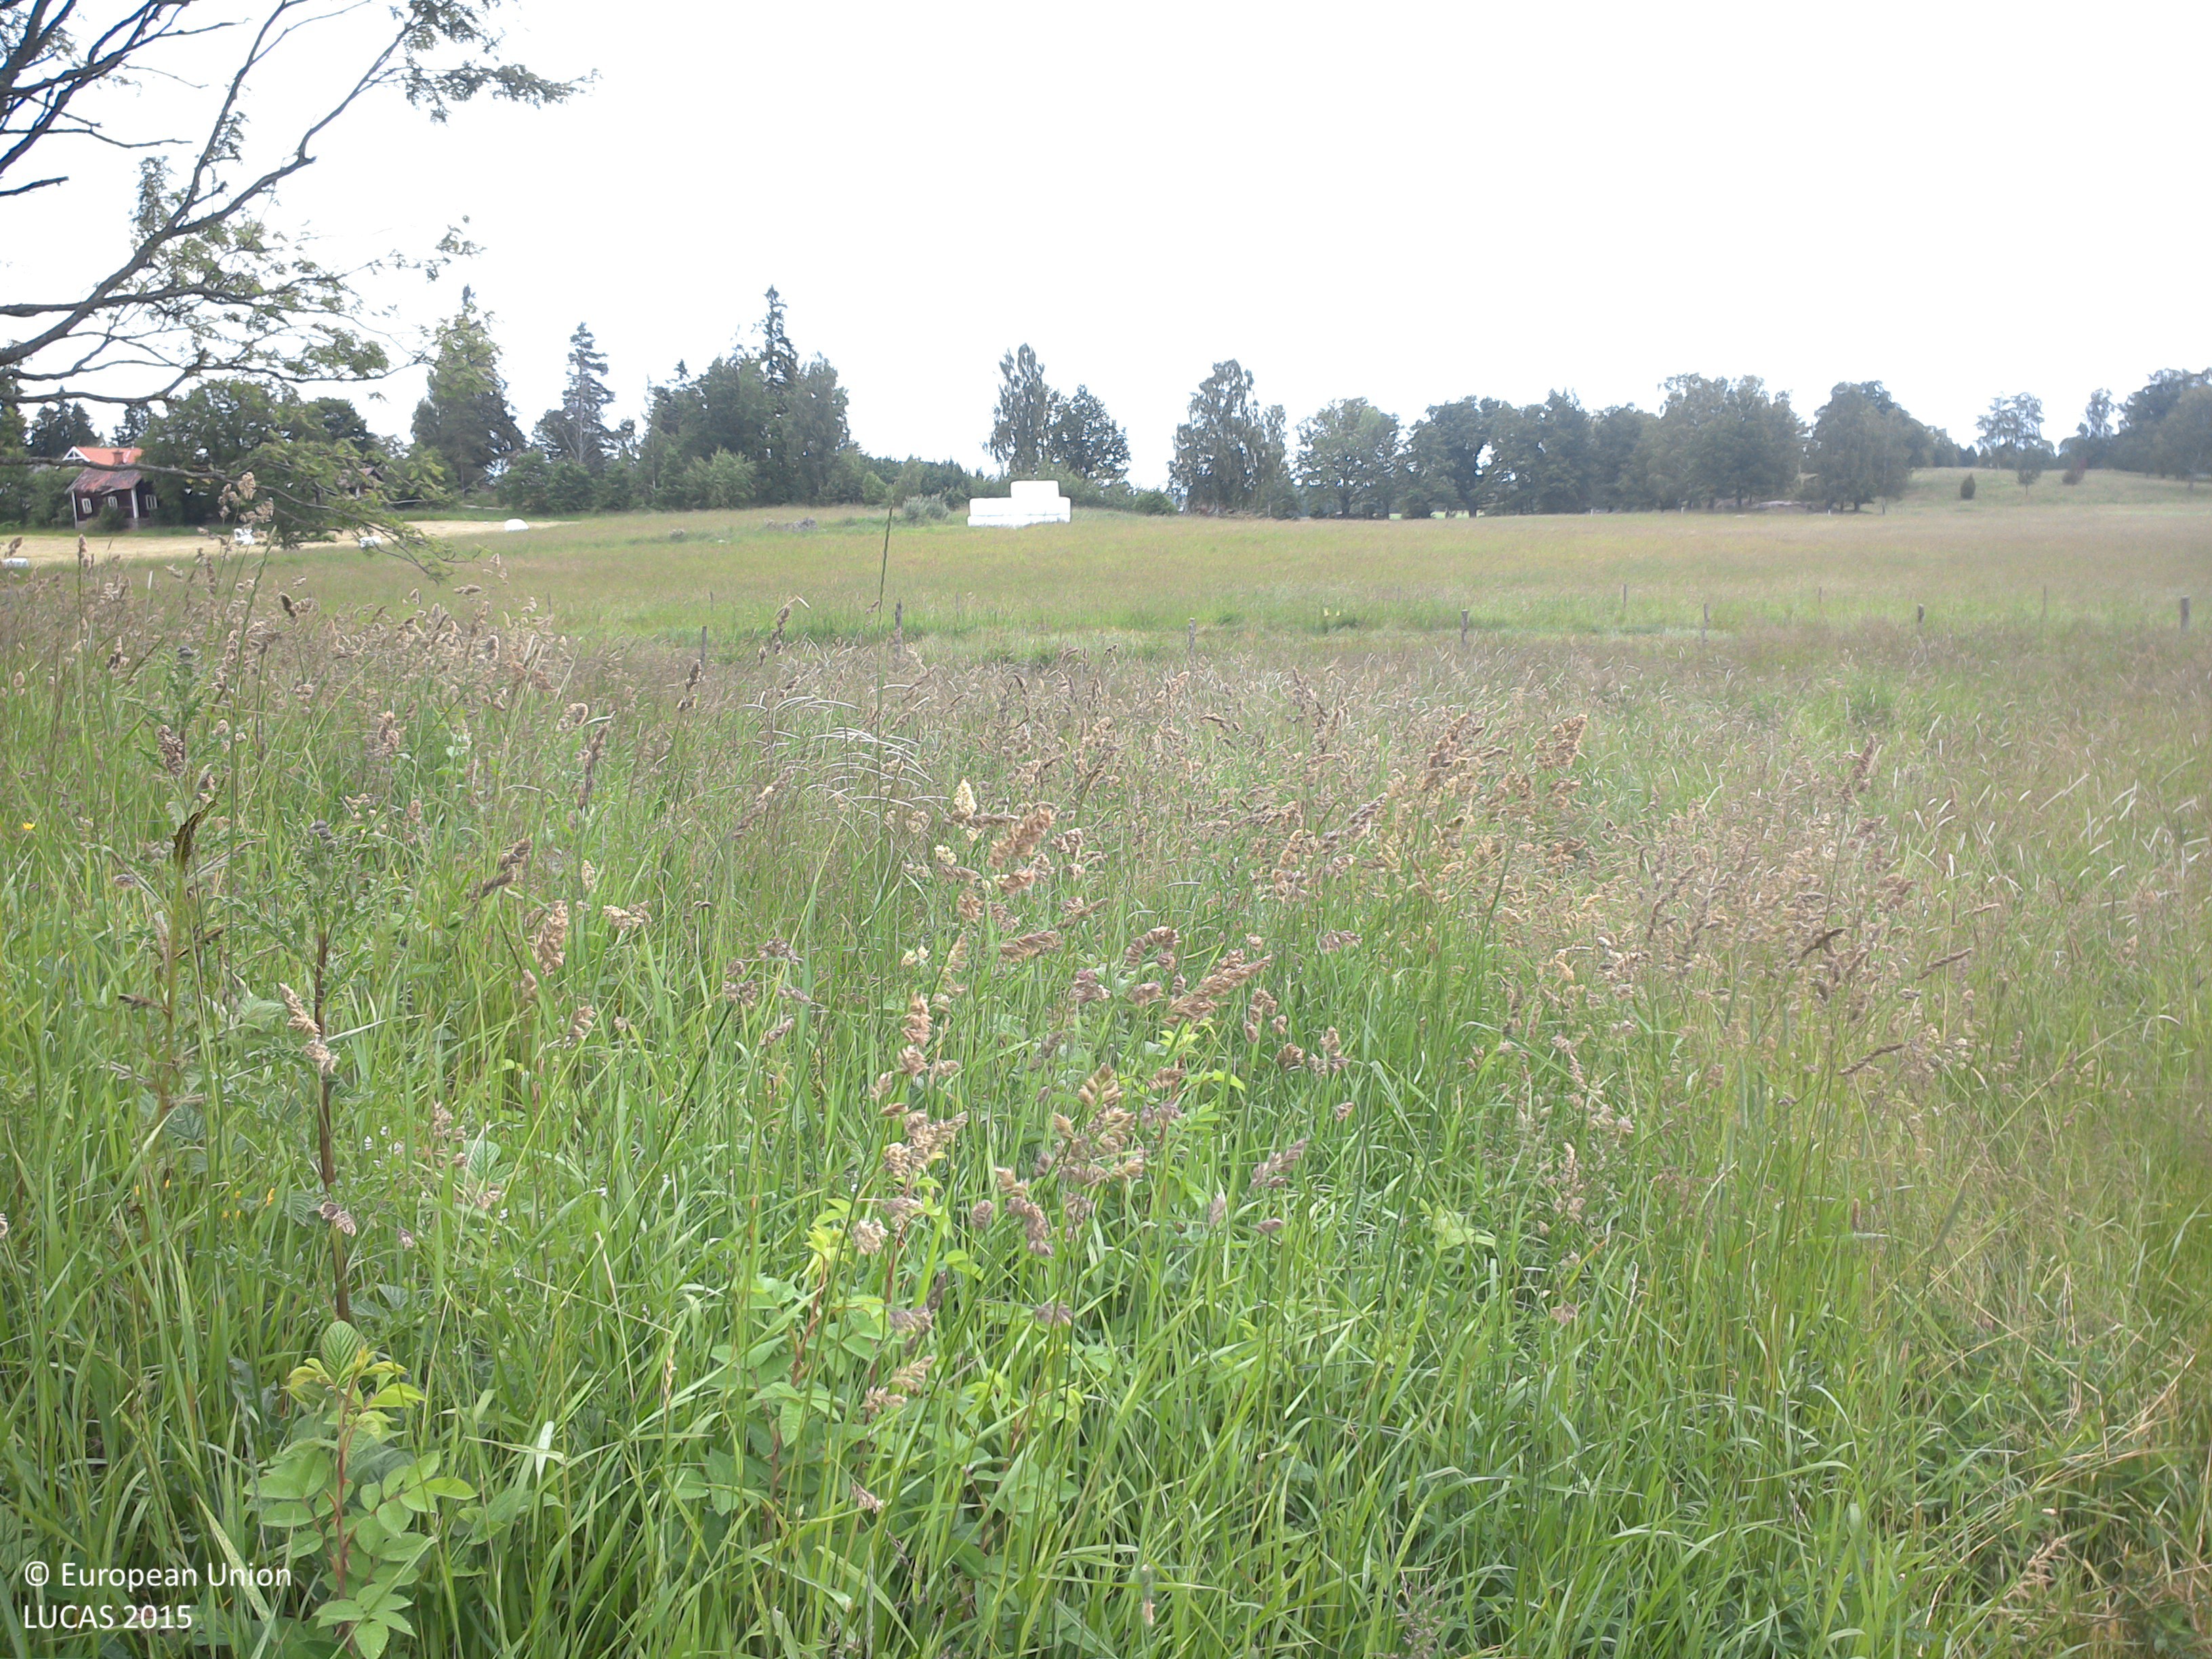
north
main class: Grassland
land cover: Grassland without tree/shrub cover
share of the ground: > 75 %
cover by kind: herbaceous plants 100 %
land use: Agriculture (excluding fallow land and kitchen gardens)
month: June
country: SE
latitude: 58.2899
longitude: 15.4360
